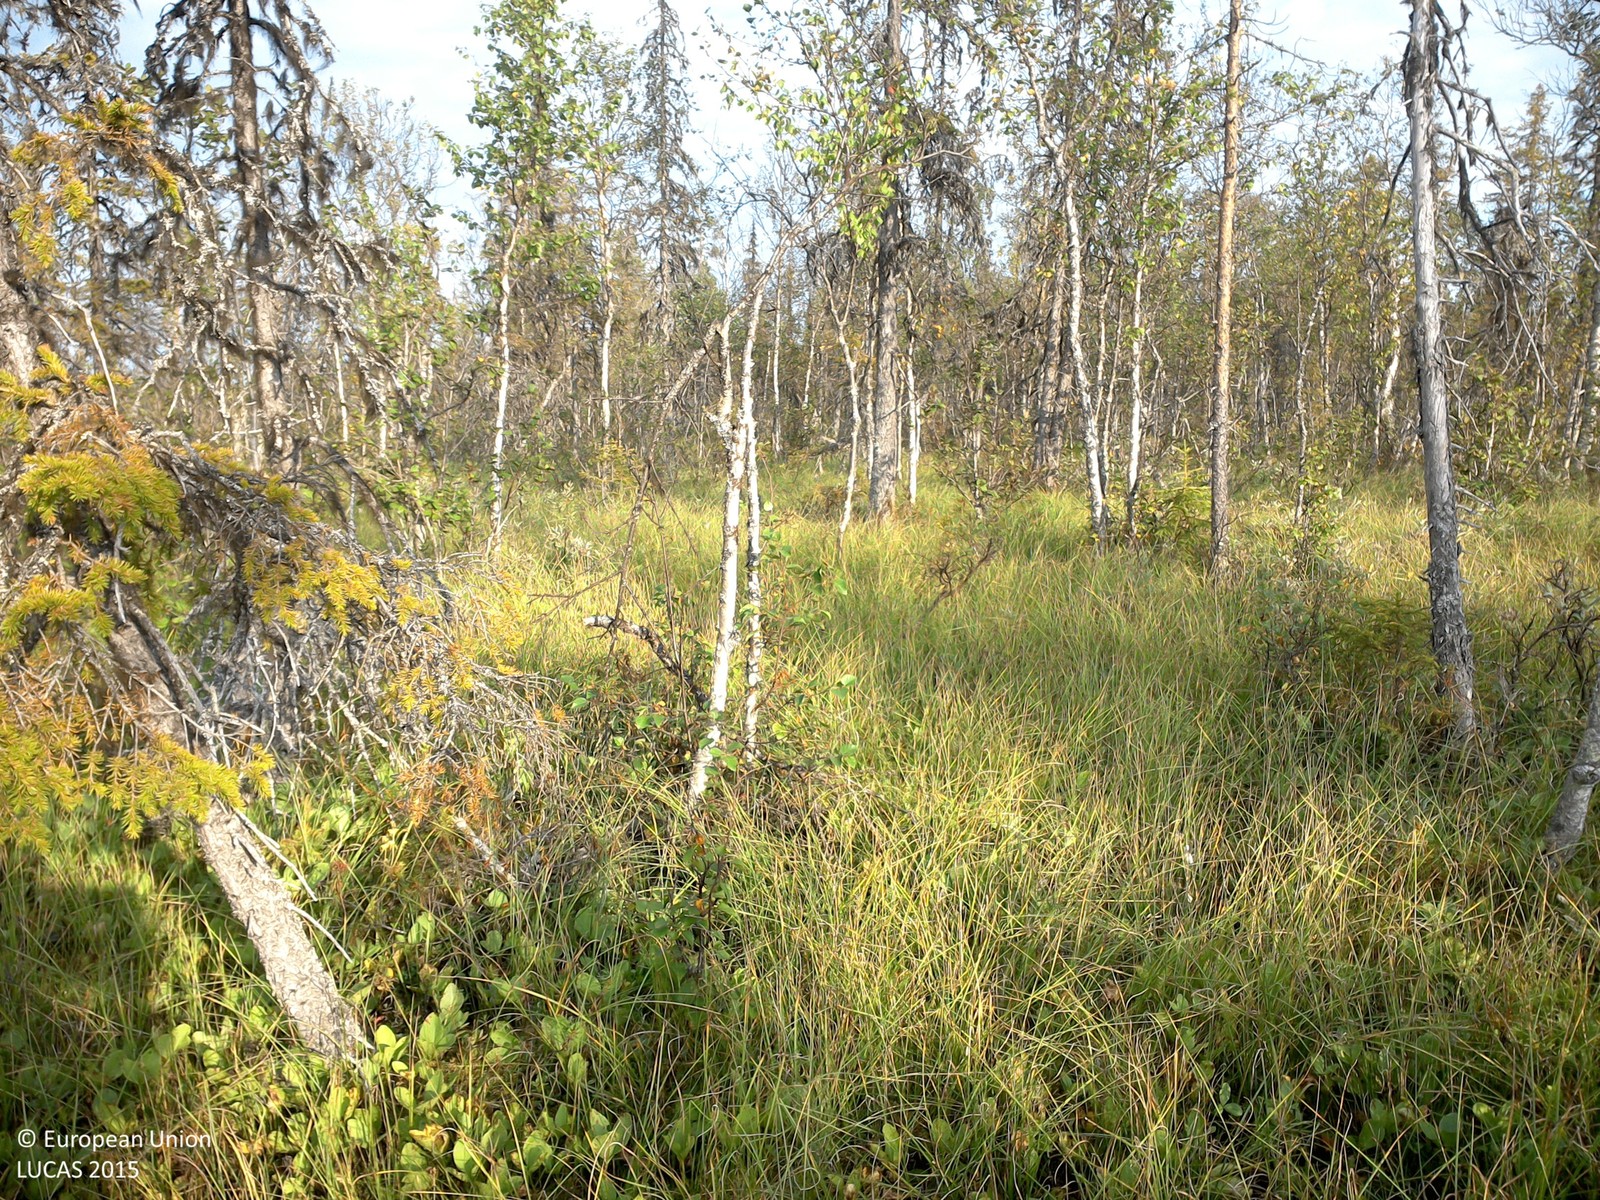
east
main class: Woodland
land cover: Other mixed woodland
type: mire and swamp forests
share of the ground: 10 - 25 %
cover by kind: herbaceous plants 55 %, lichens and mosses 20 %, coniferous forest trees 10 %, shrubs 10 %, broadleaved forest trees 5 %
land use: Semi-natural and natural areas not in use
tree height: > 5 m
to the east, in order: Other mixed woodland; Broadleaved woodland; Pine dominated mixed woodland; Pine dominated coniferous woodland
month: August
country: SE
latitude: 67.2615
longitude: 21.9890
